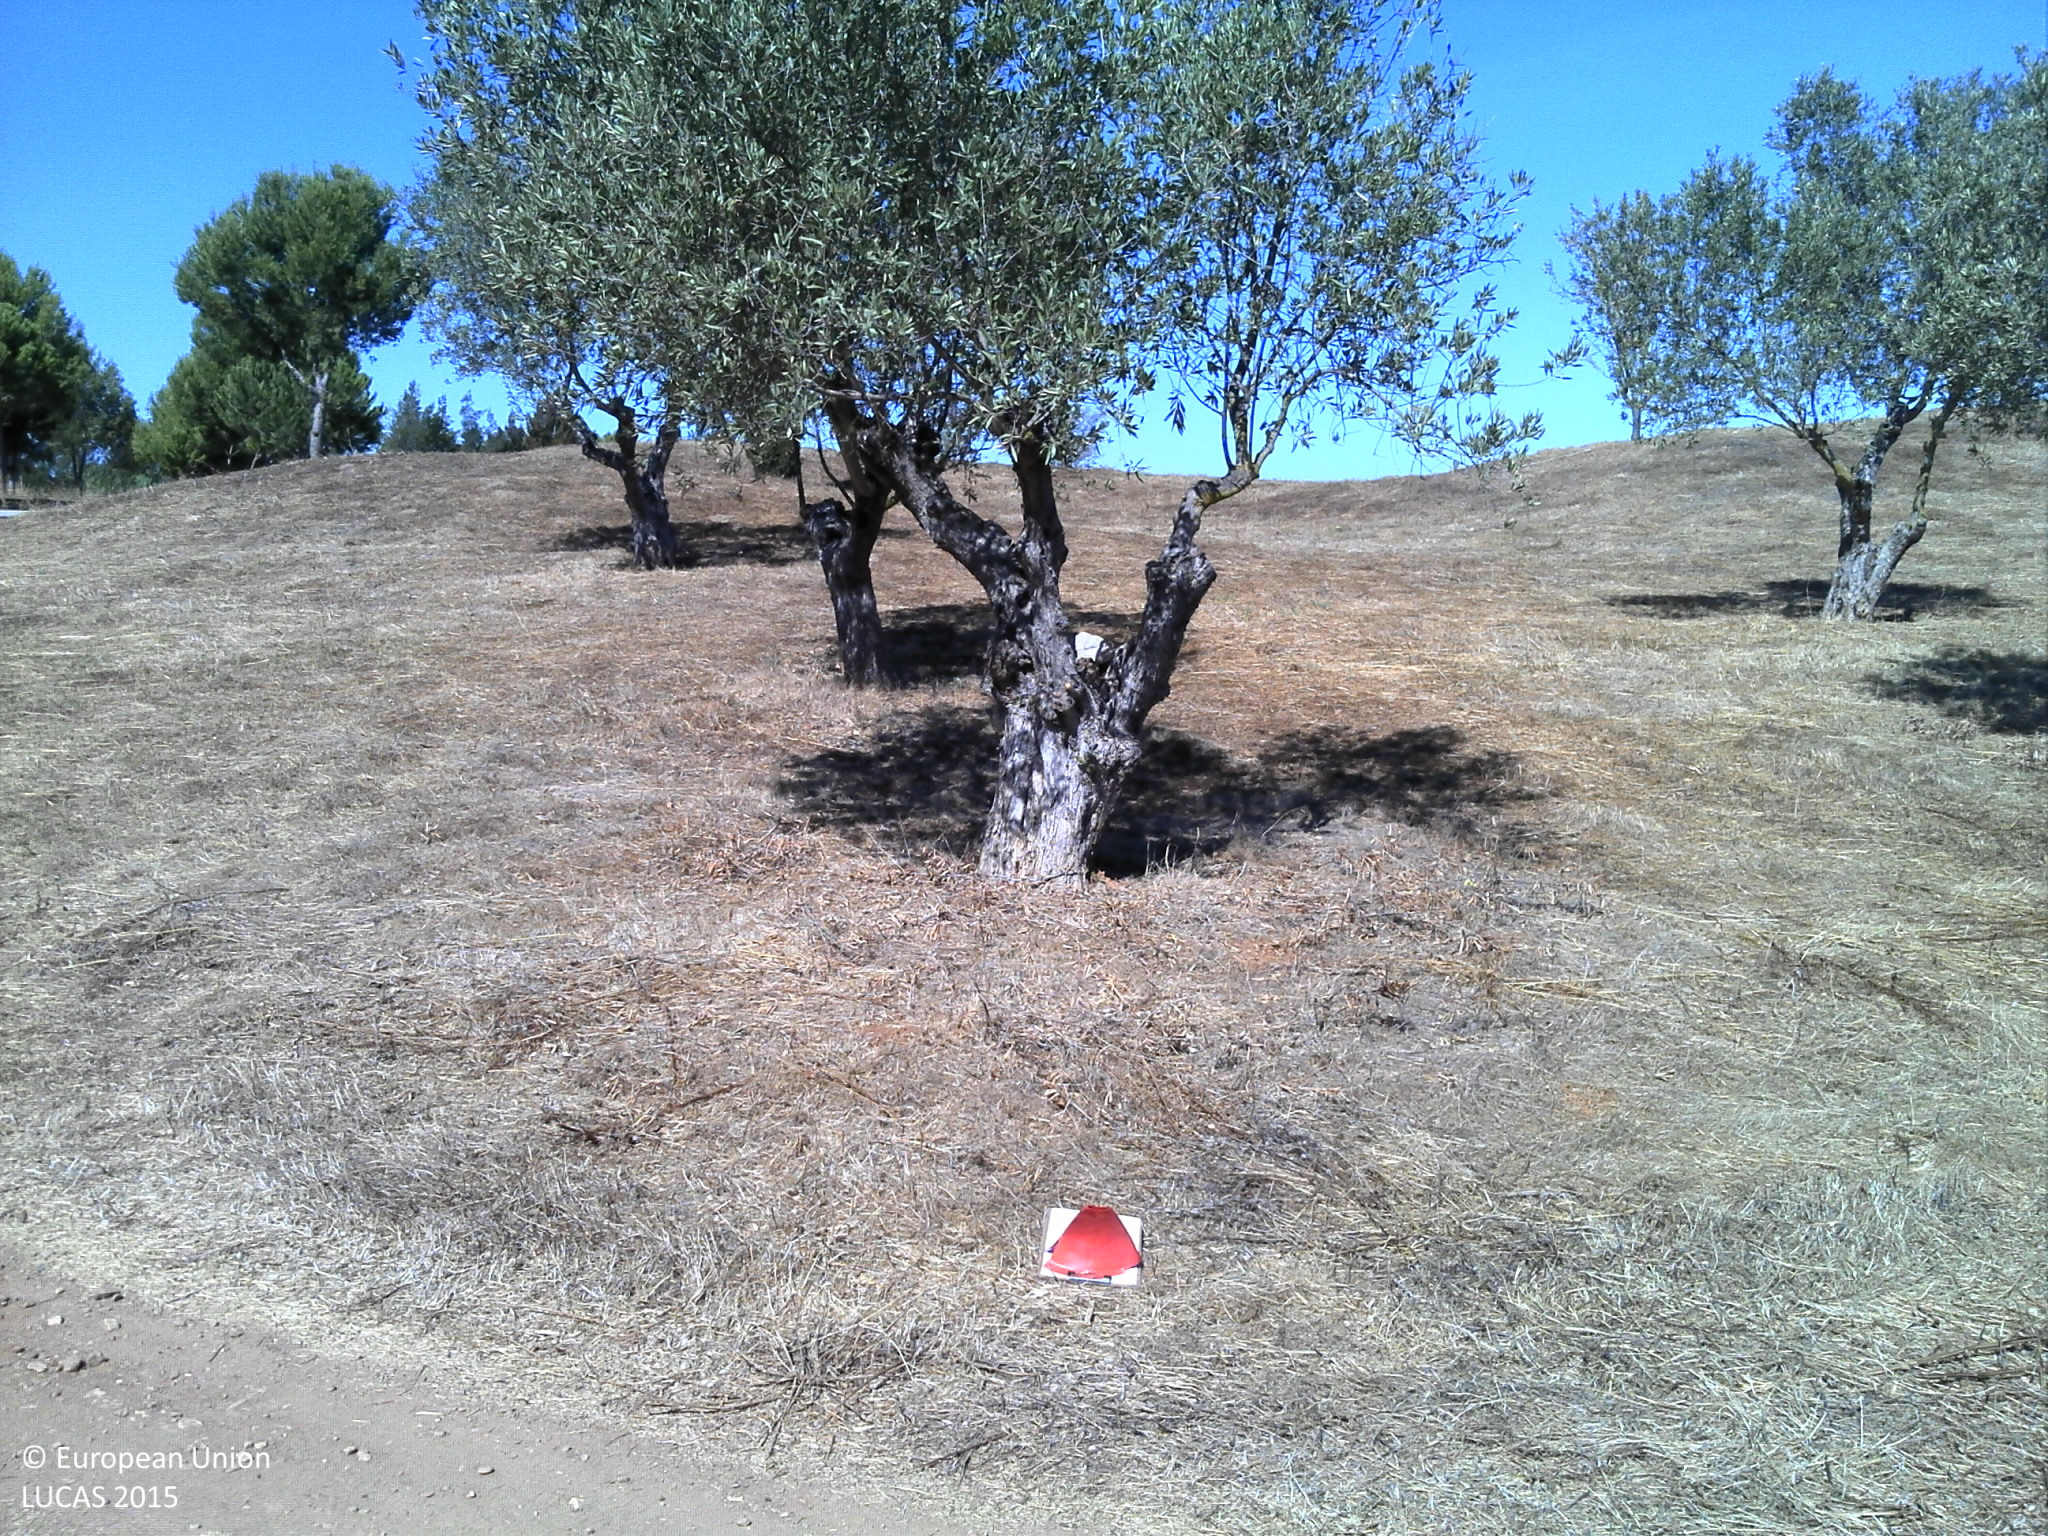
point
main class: Cropland
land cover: Olive groves
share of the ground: 25 - 50 %
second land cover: Grassland without tree/shrub cover
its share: 50 - 75 %
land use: Amenities, museums, leisure
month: September
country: PT
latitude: 37.0982
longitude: -8.1413
